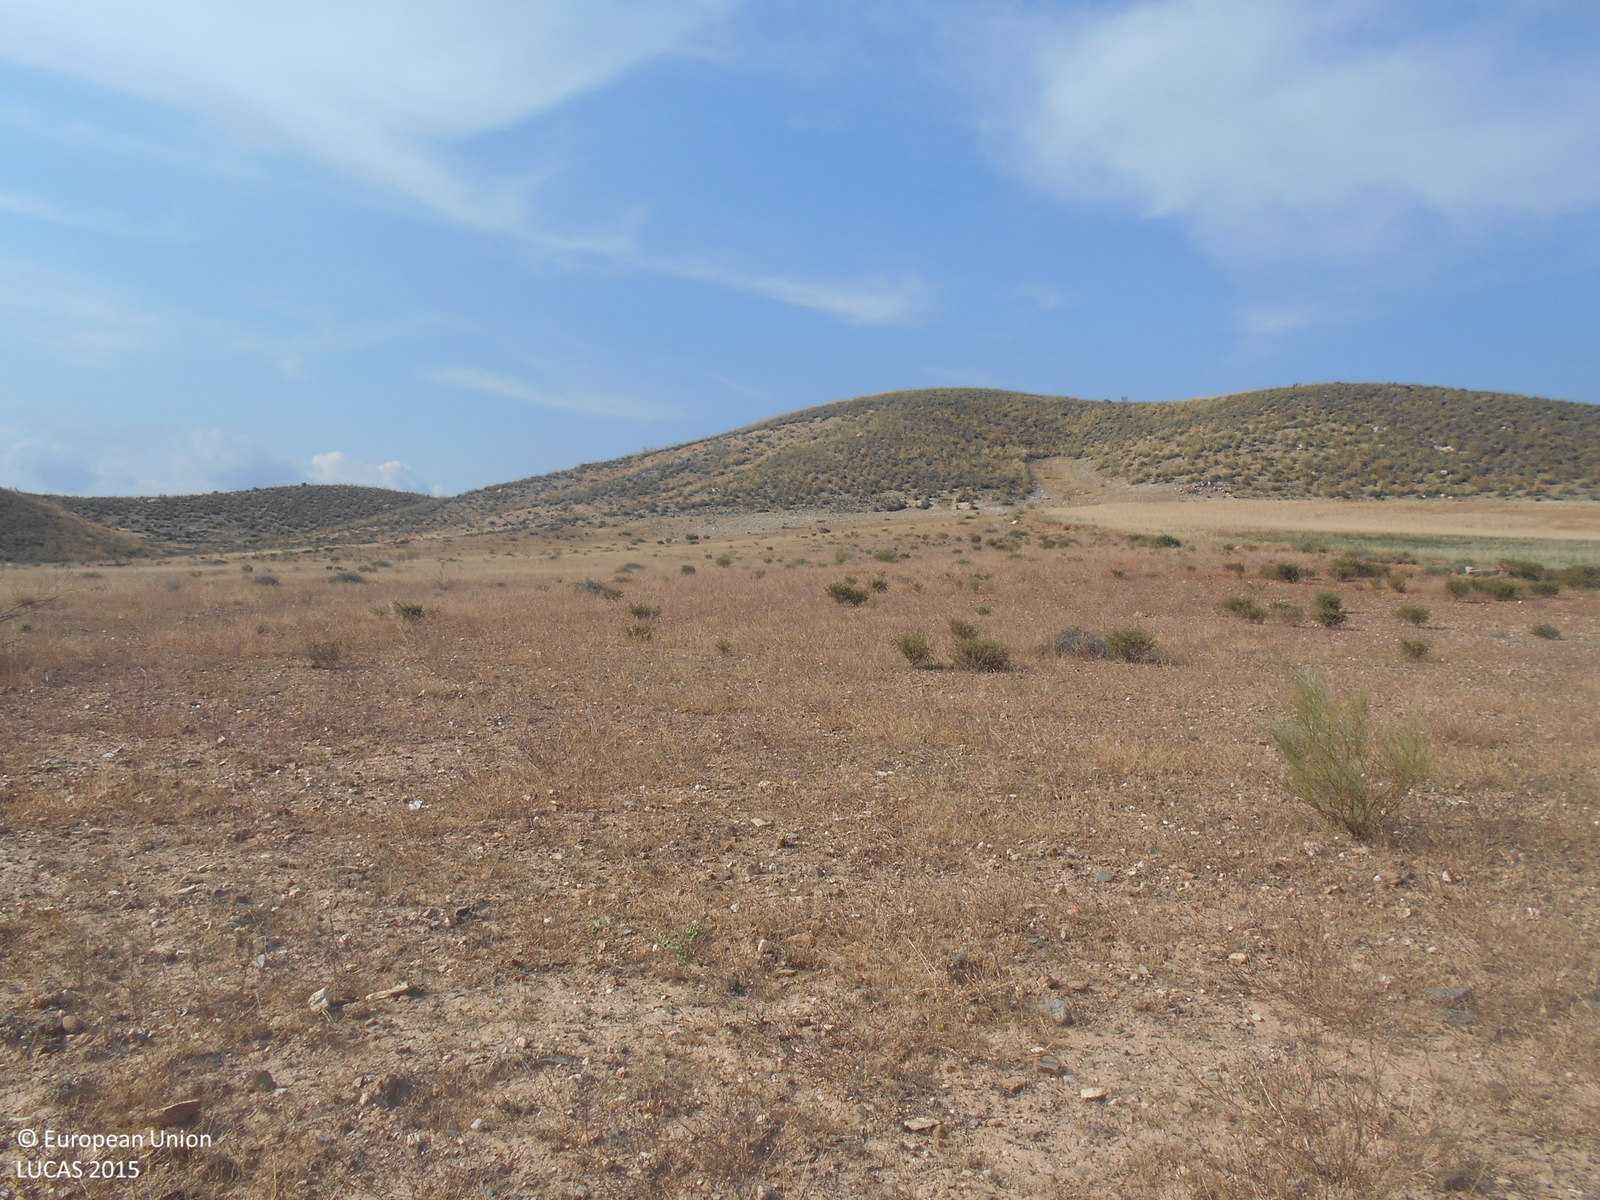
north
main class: Grassland
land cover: Grassland without tree/shrub cover
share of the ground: 25 - 50 %
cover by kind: unconsolidated bare surface 60 %, herbaceous plants 35 %, shrubs 5 %
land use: Abandoned areas
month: May
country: ES
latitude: 37.0598
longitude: -2.2690
